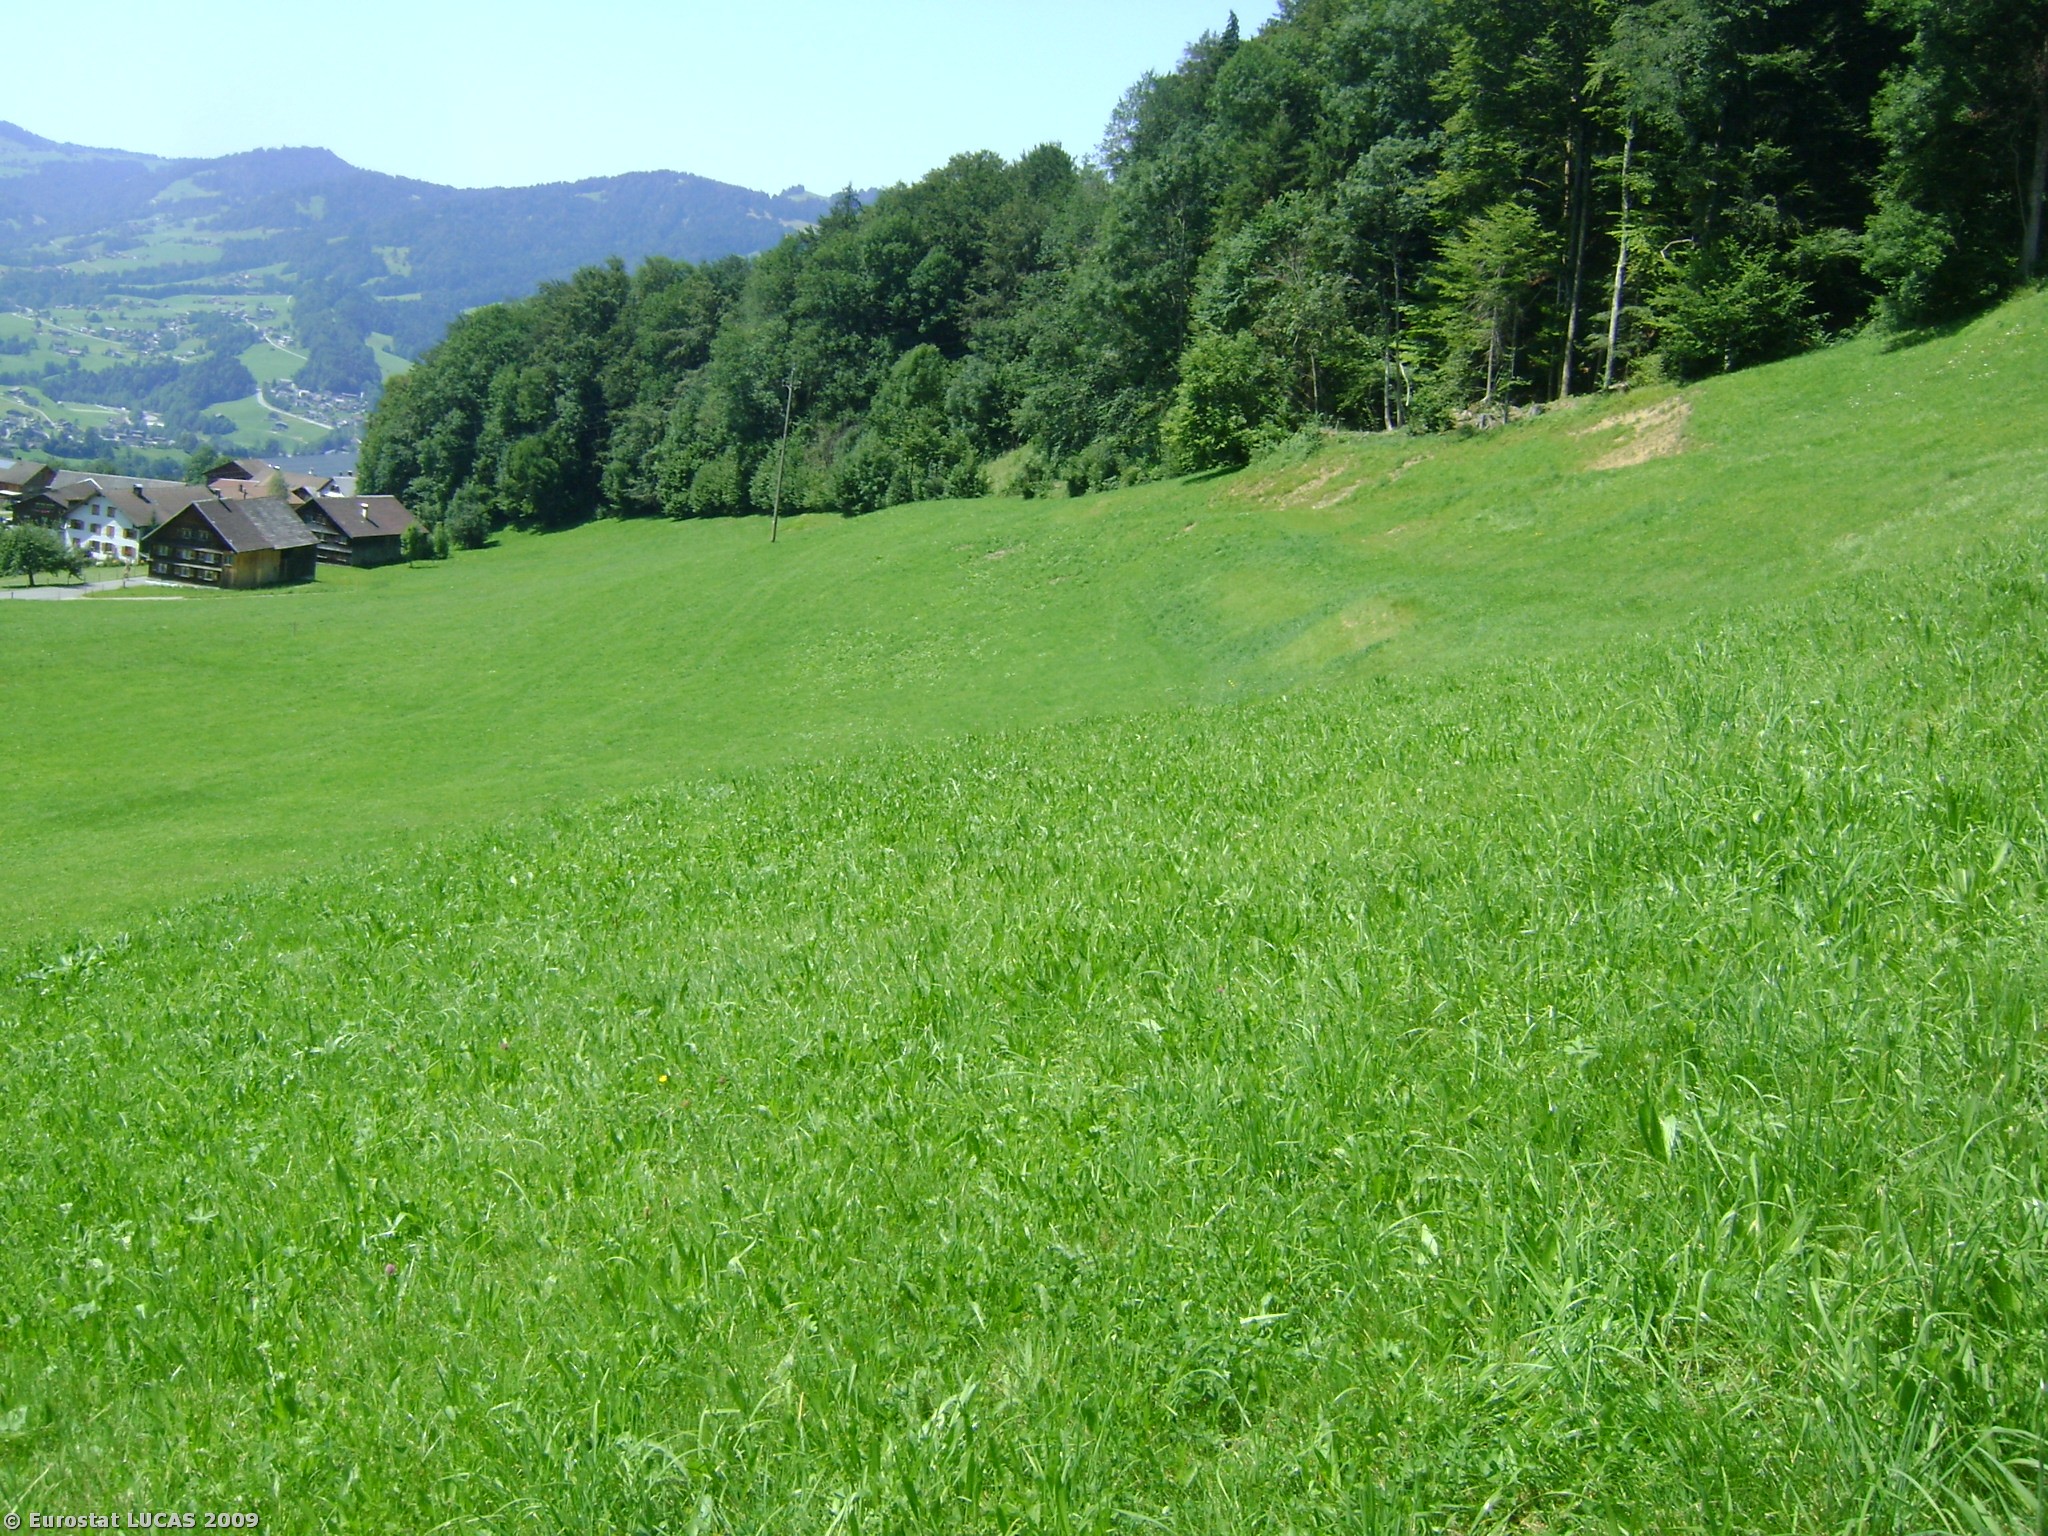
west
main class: Grassland
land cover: Grassland without tree/shrub cover
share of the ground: > 75 %
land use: Agriculture (excluding fallow land and kitchen gardens)
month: August
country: AT
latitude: 47.4316
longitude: 9.9338
